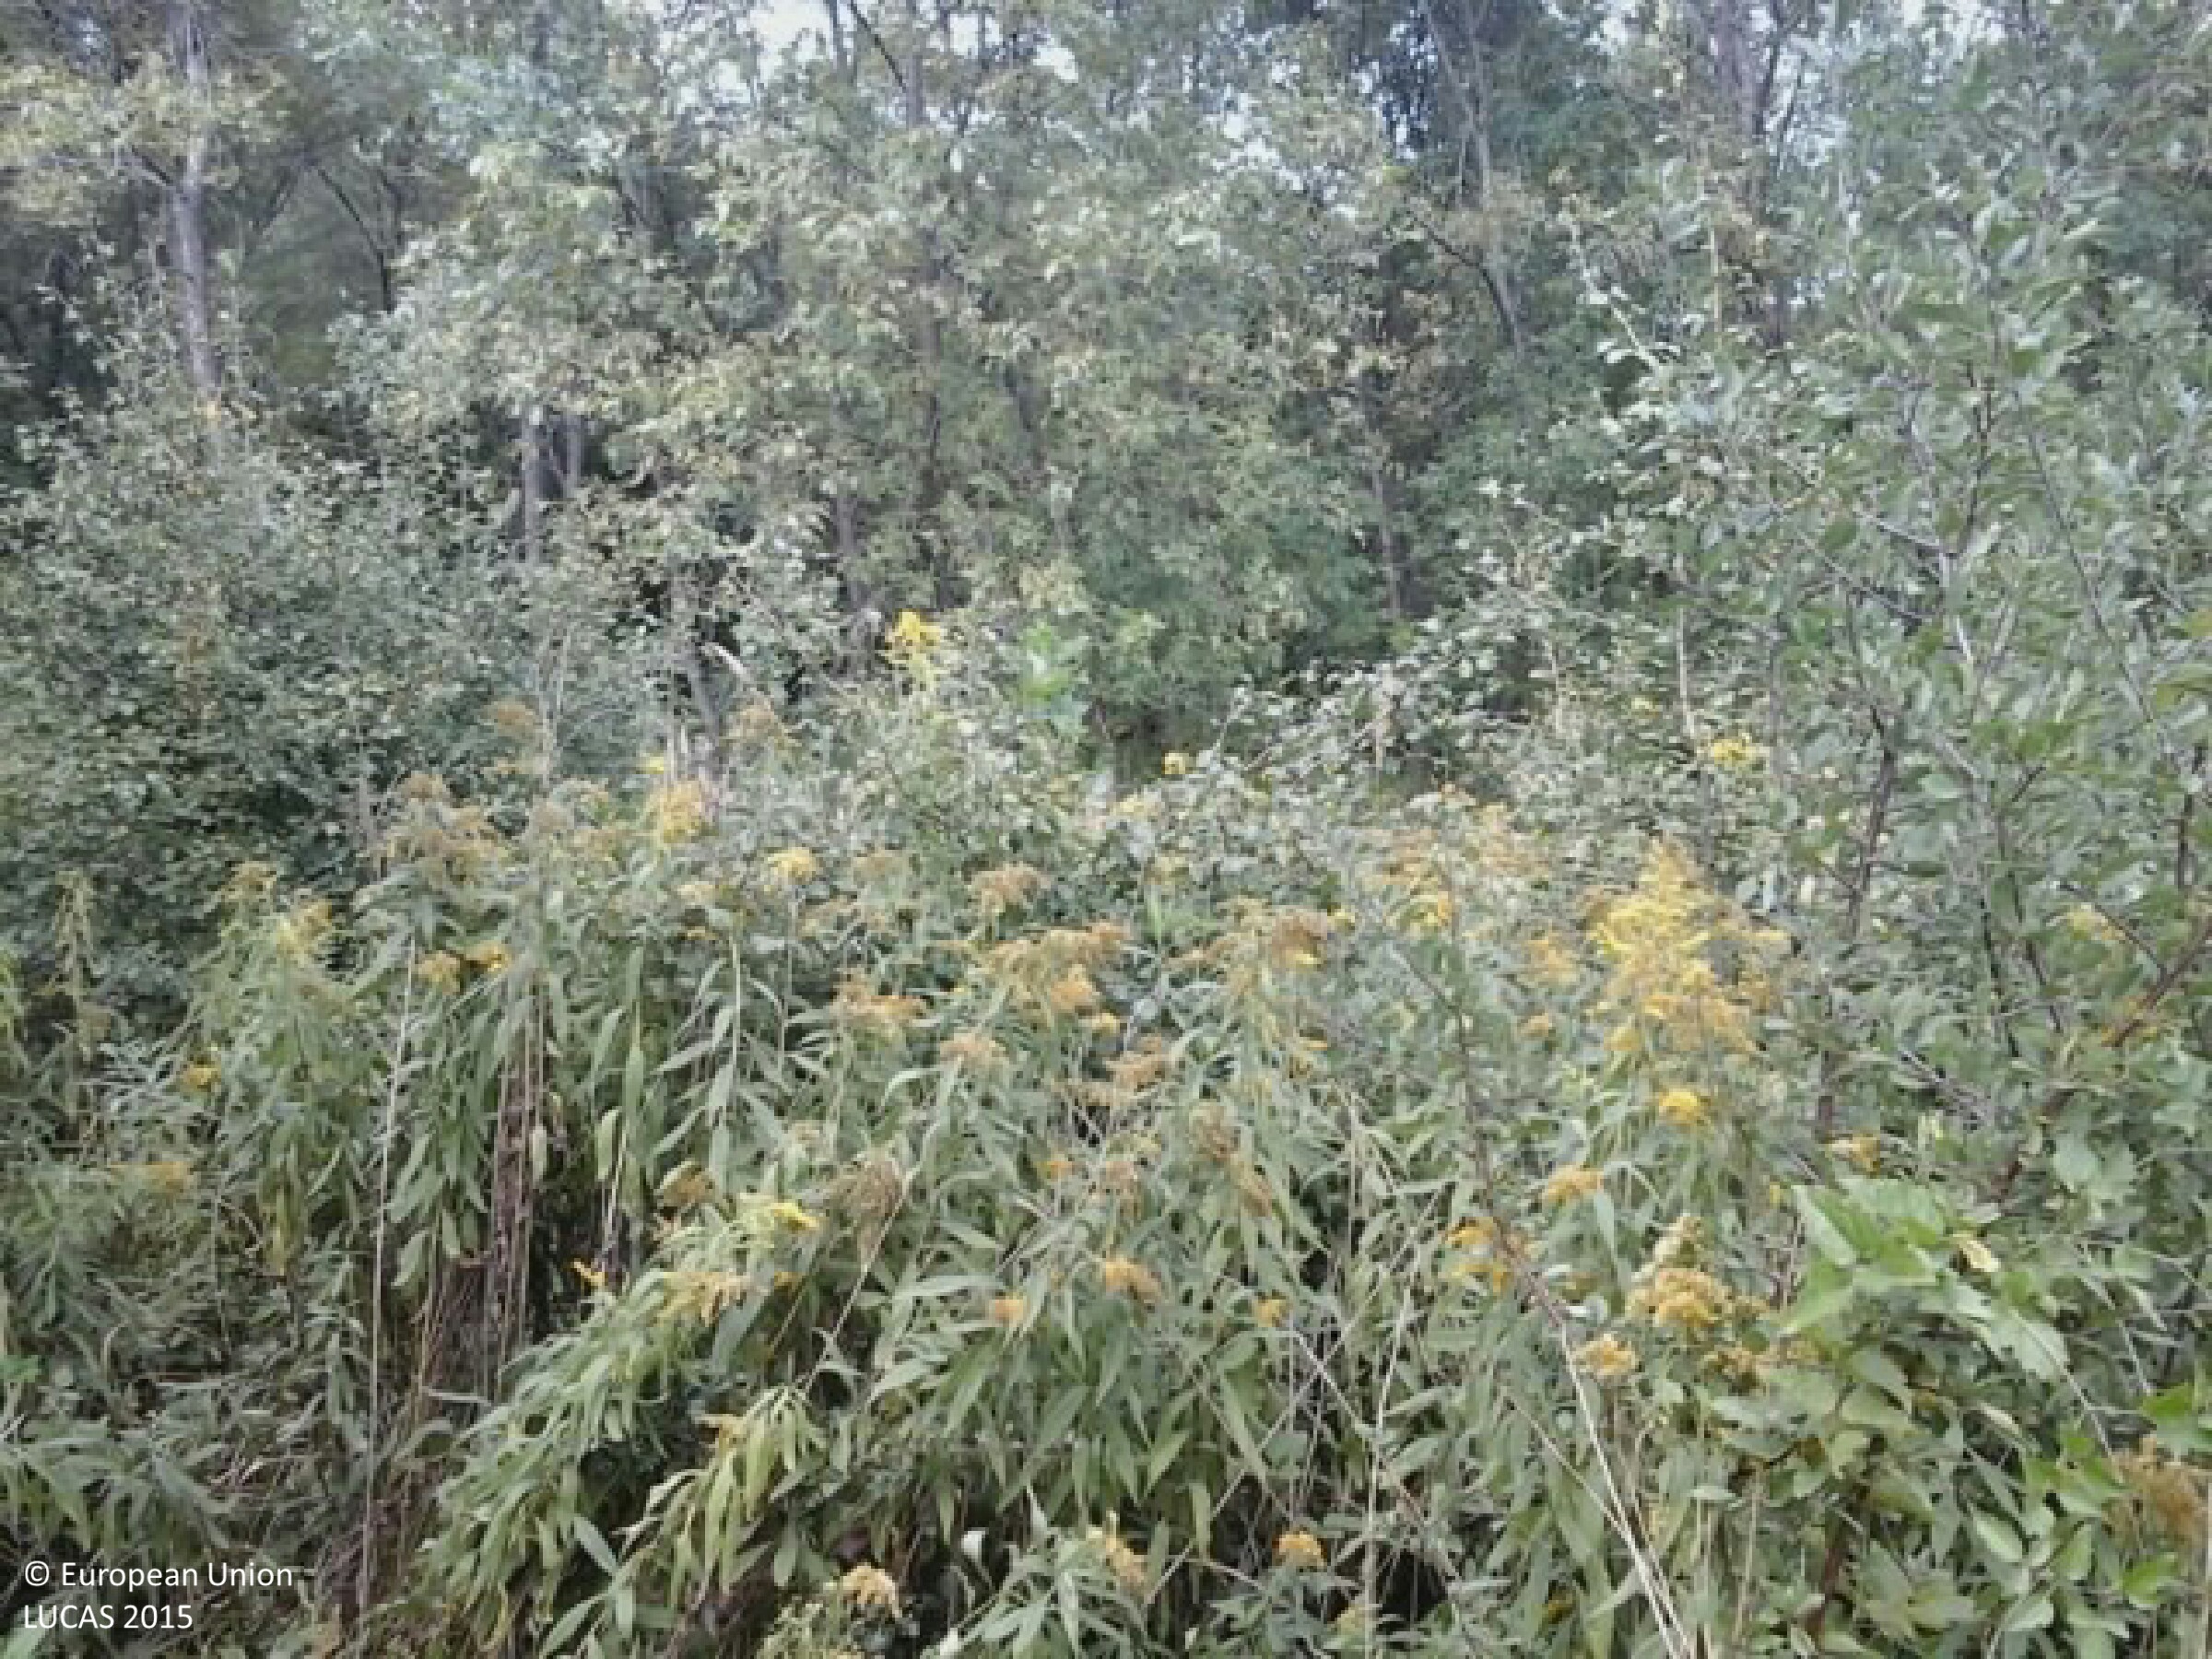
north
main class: Grassland
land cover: Spontaneously vegetated surfaces
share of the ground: > 75 %
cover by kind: herbaceous plants 95 %, shrubs 5 %
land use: Fallow land
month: August
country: HU
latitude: 46.8061
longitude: 18.3050
